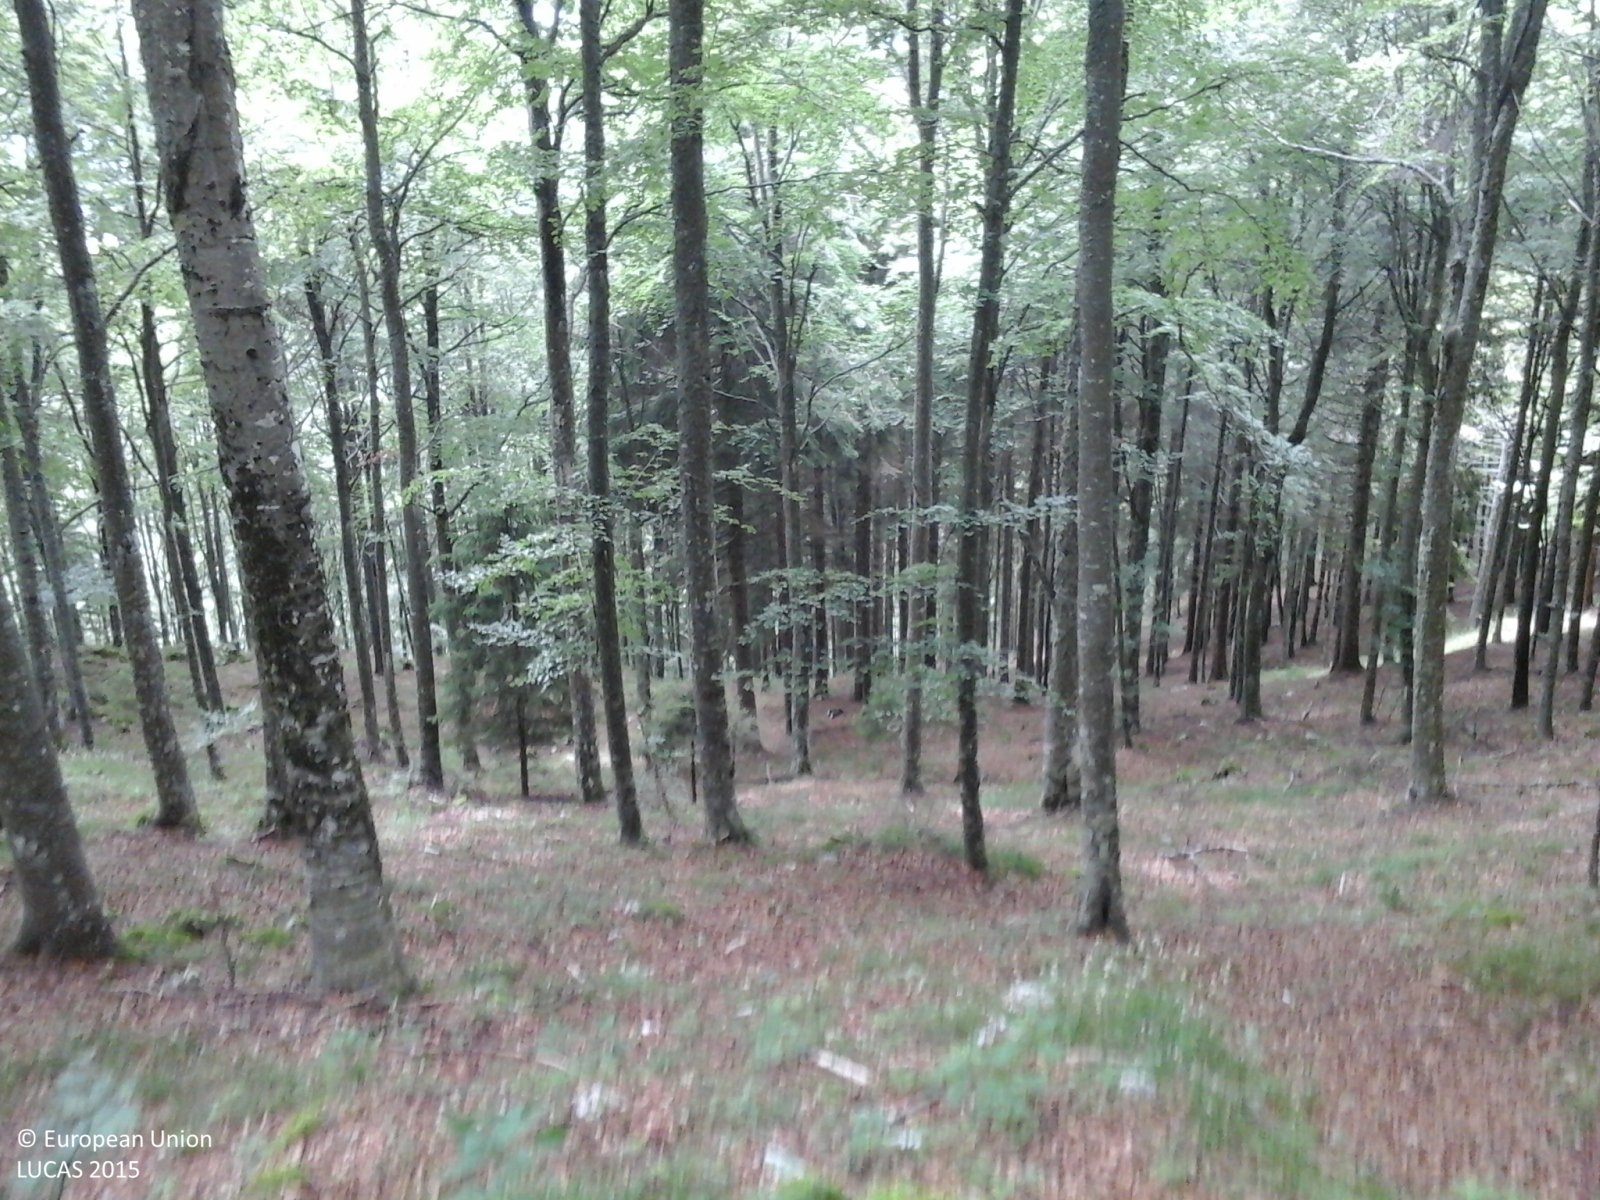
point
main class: Woodland
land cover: Broadleaved woodland
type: mountainous beech forest
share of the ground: > 75 %
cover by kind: broadleaved forest trees 100 %
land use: Forestry
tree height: > 5 m
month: June
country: IT
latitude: 46.1431
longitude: 12.4438
